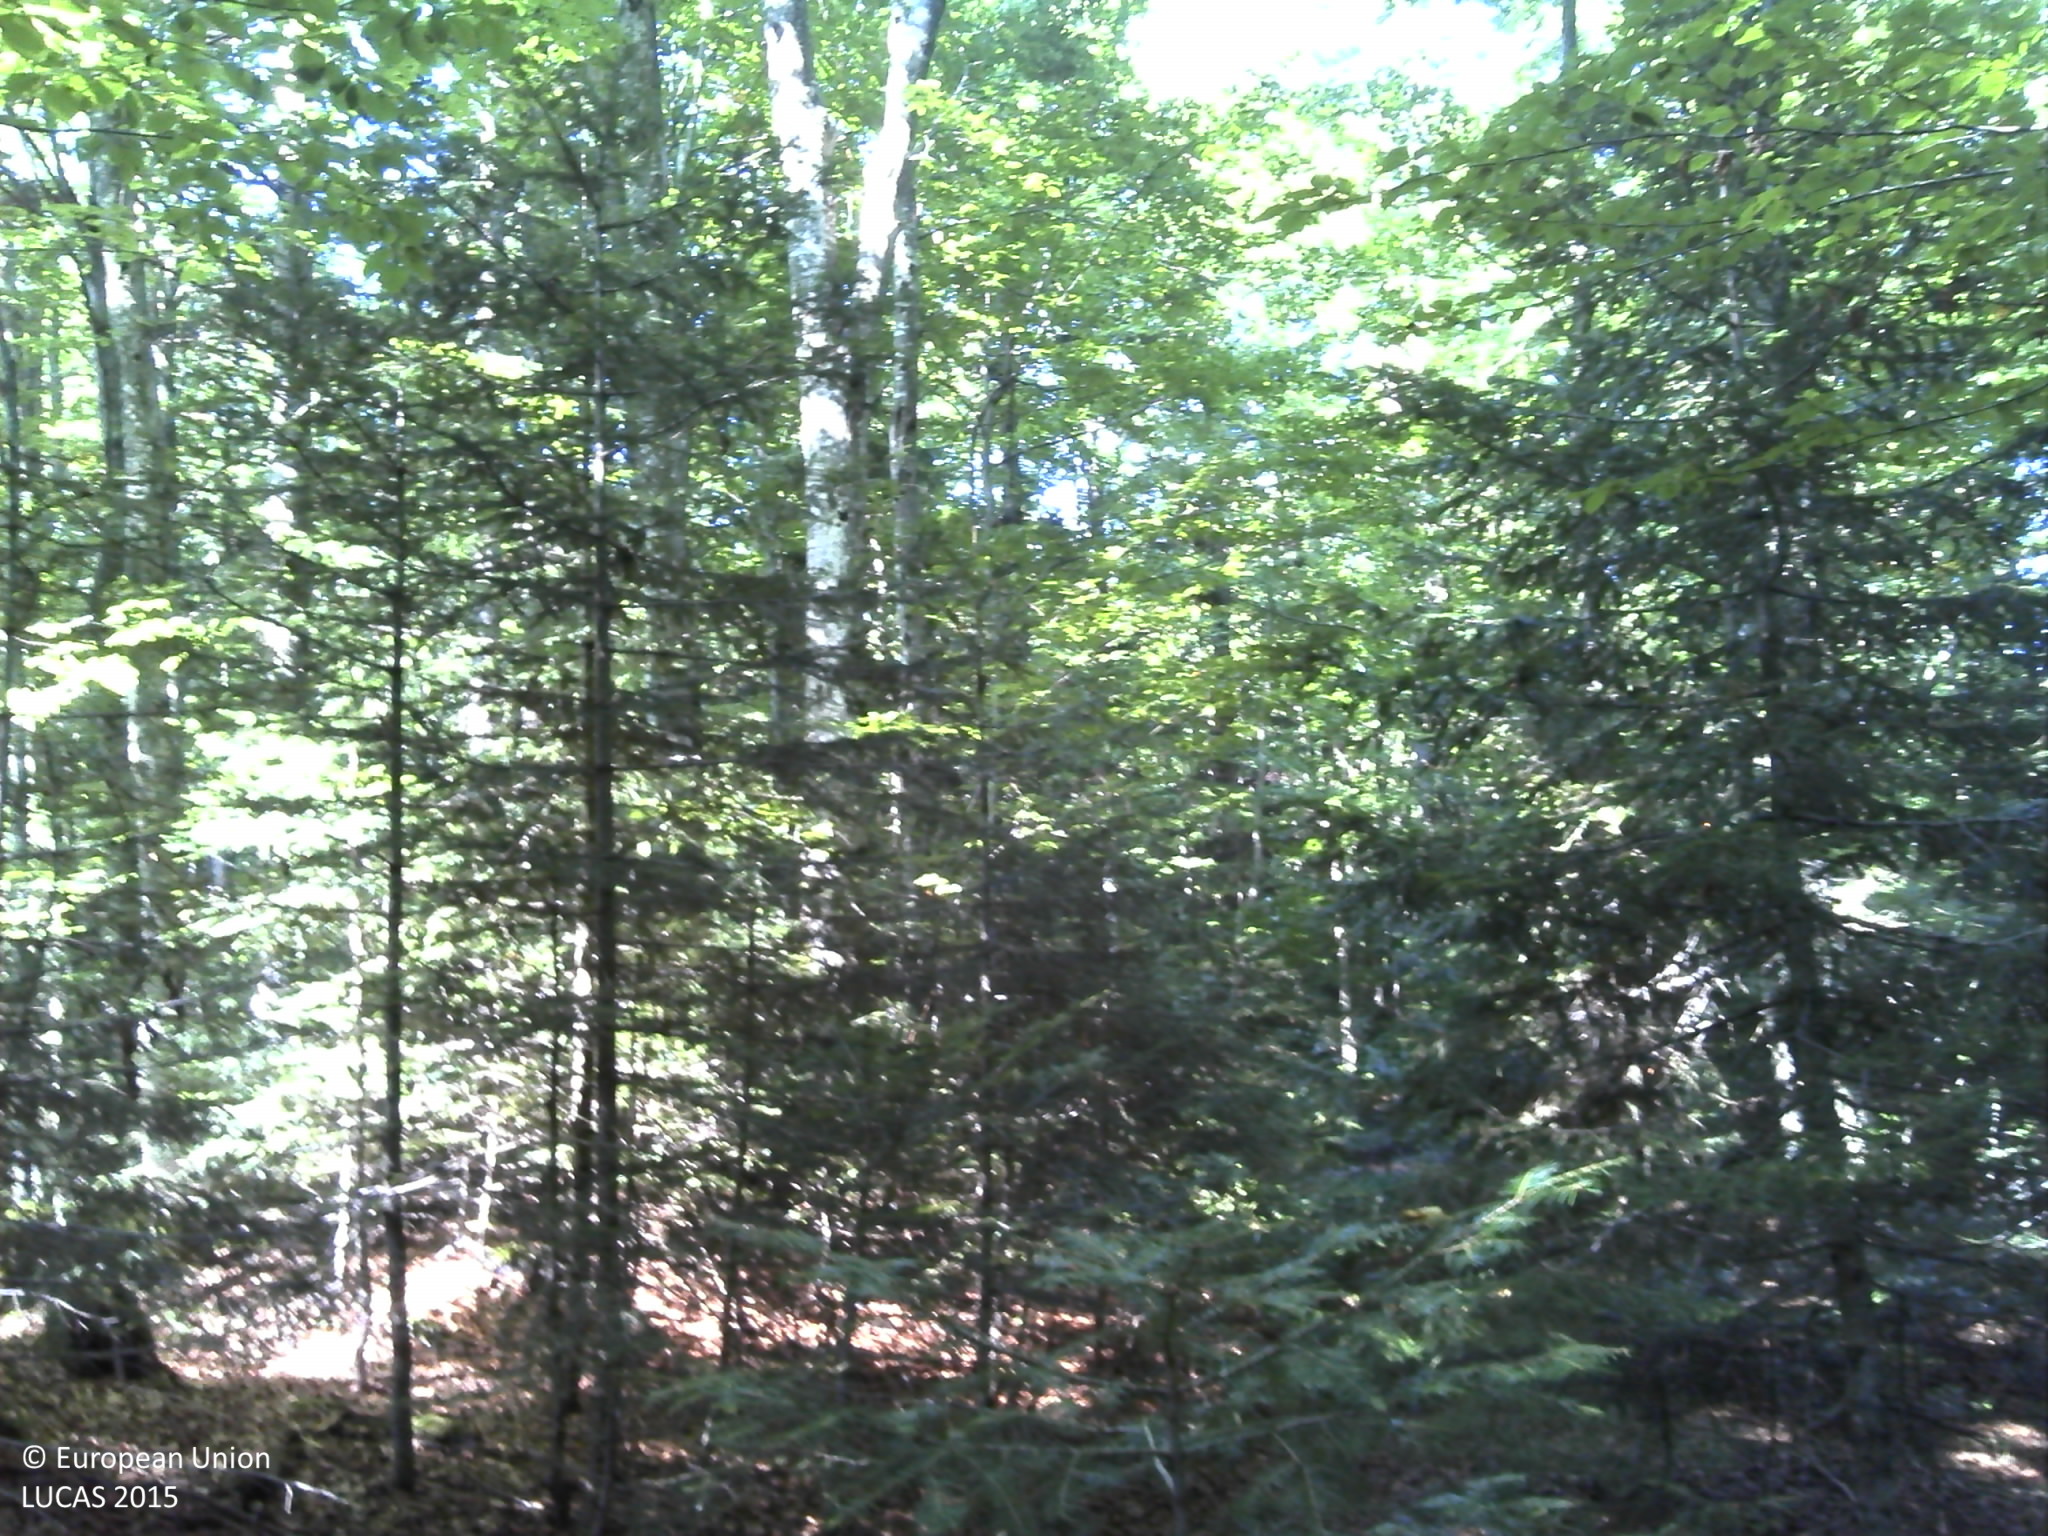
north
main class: Woodland
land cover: Broadleaved woodland
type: beech forest
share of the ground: > 75 %
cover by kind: broadleaved forest trees 70 %, coniferous forest trees 10 %, shrubs 10 %, consolidated bare surface 10 %
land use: Forestry
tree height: > 5 m
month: August
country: HR
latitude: 44.9232
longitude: 15.5817
